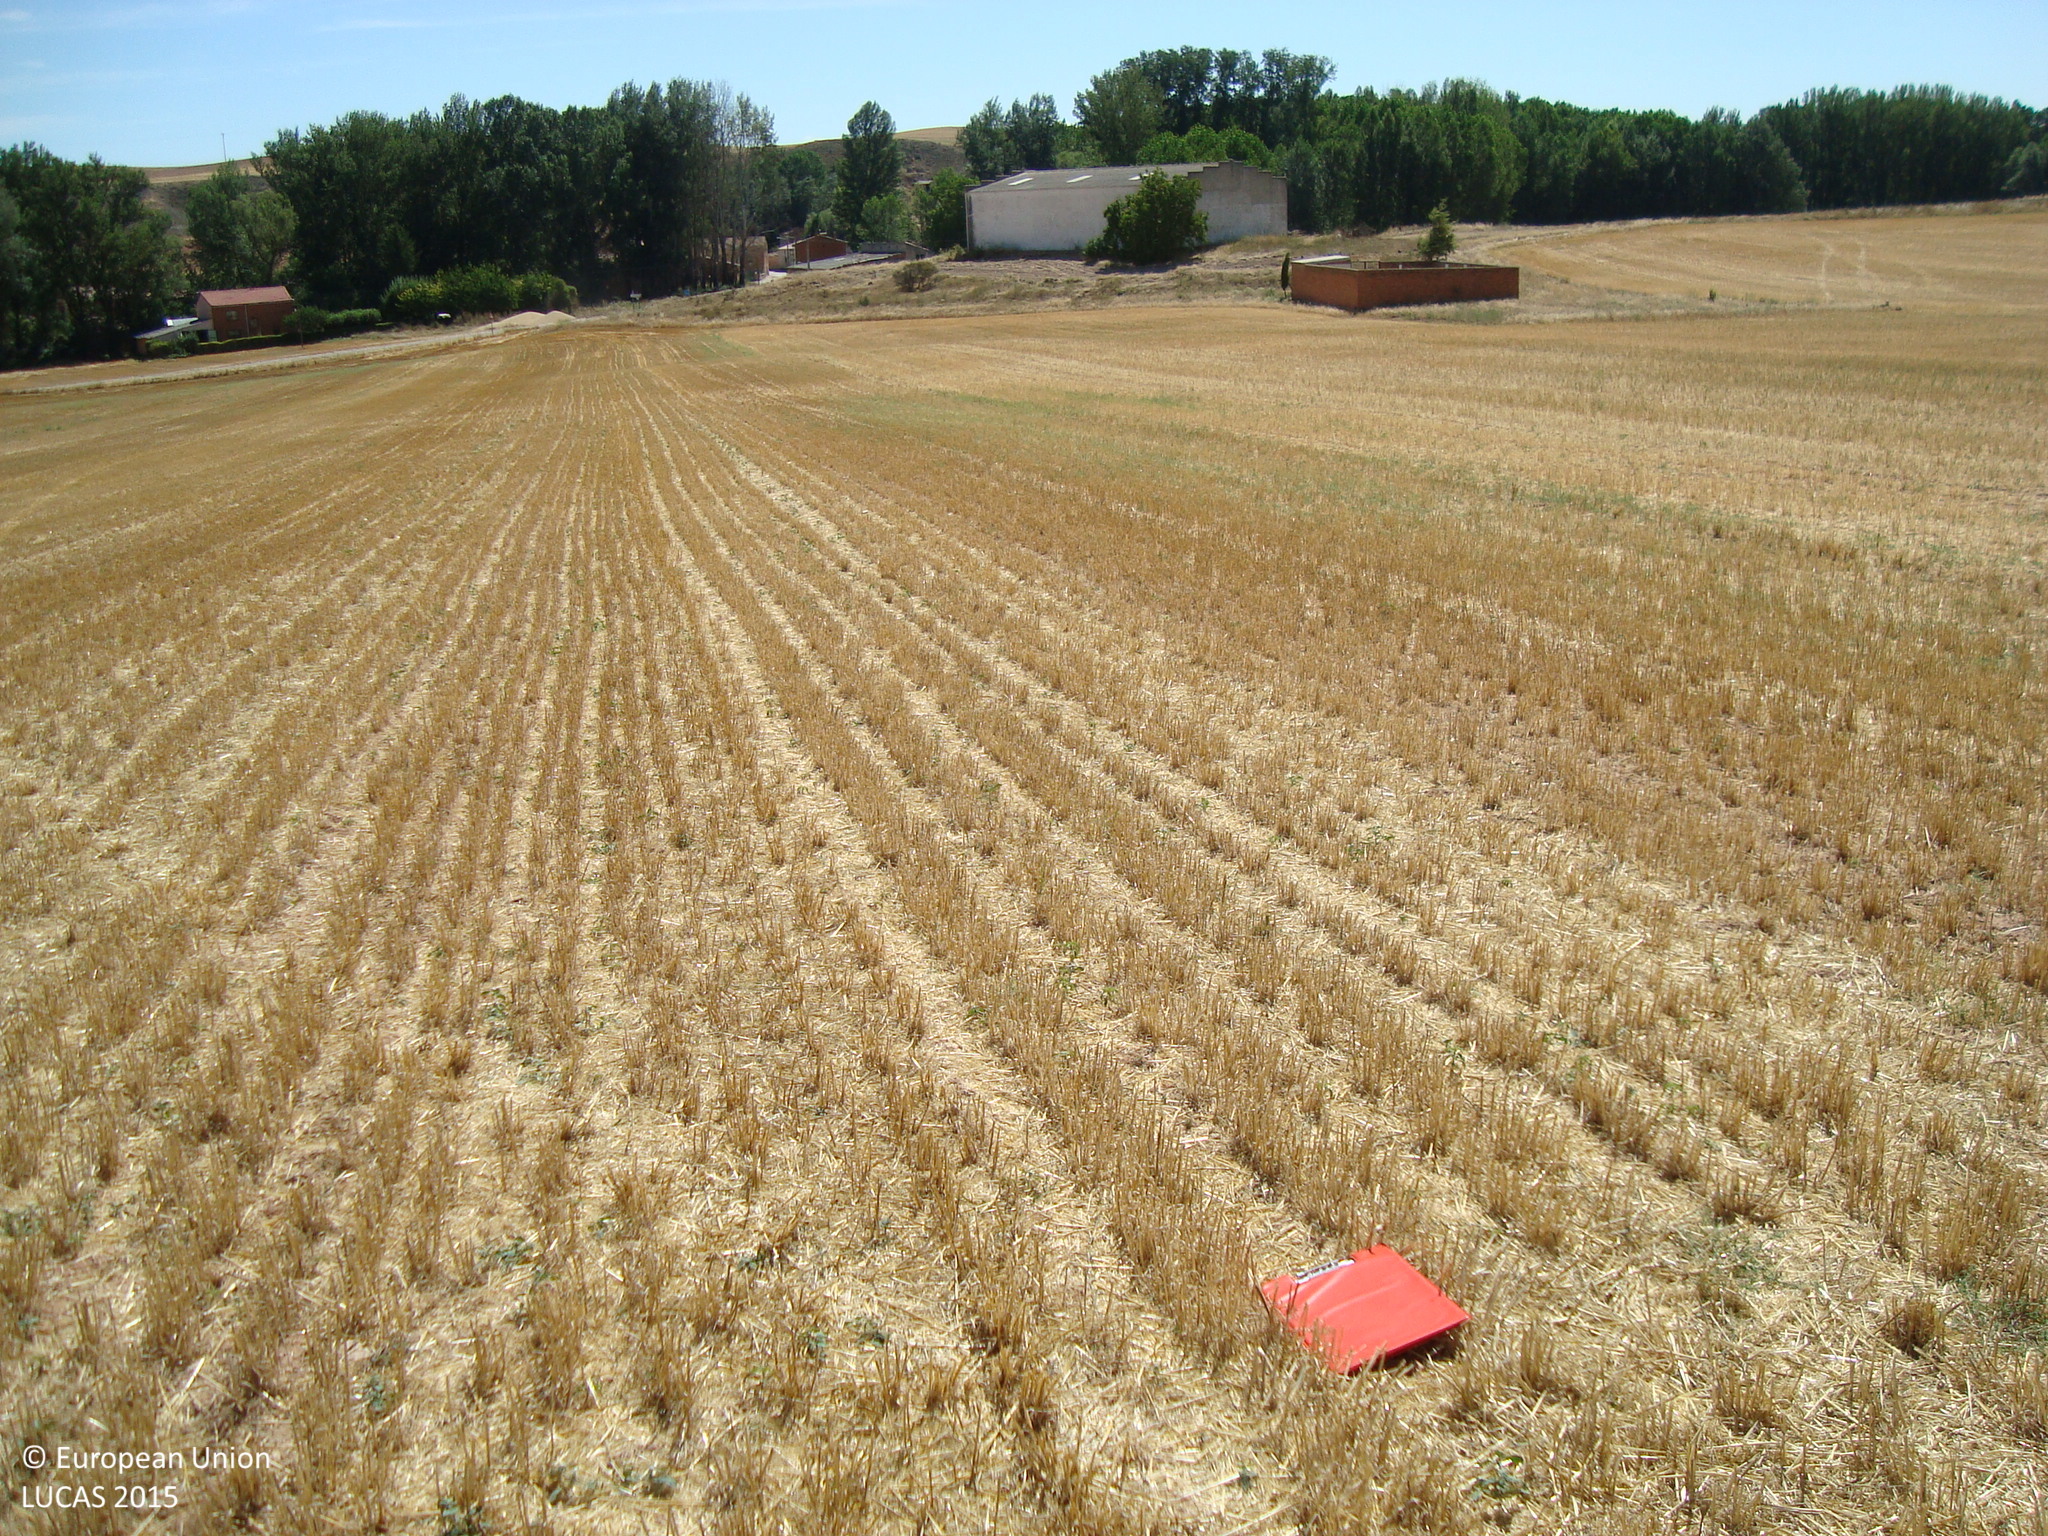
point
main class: Cropland
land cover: Barley
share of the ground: > 75 %
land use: Agriculture (excluding fallow land and kitchen gardens)
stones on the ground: 10 - 25 %
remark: Harvested field
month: July
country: ES
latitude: 42.0214
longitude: -3.8878
